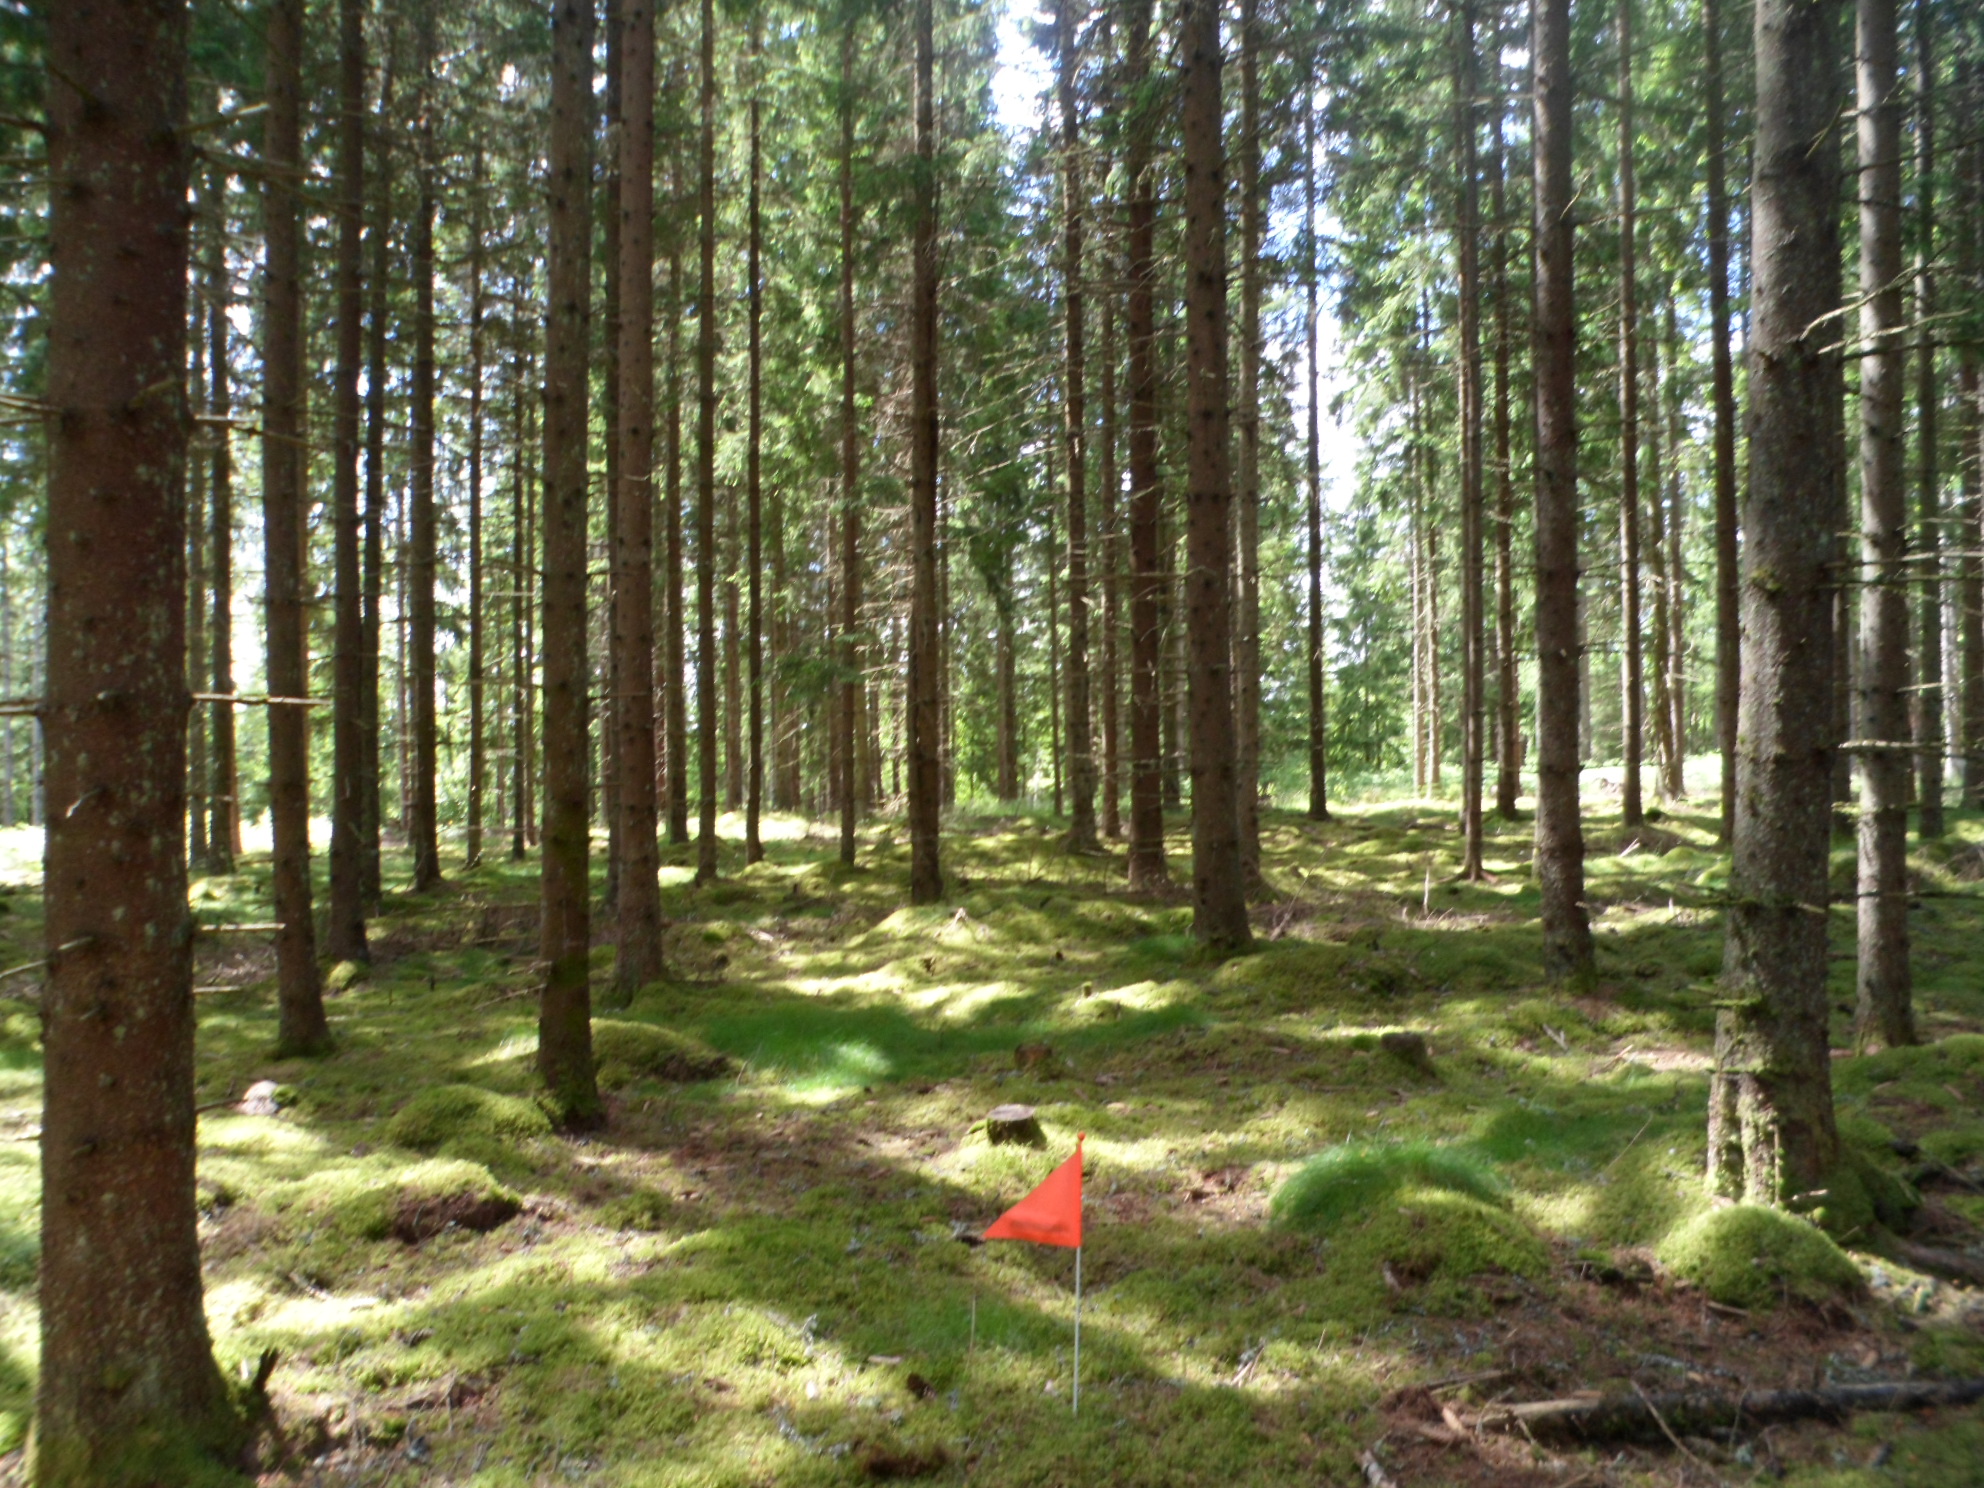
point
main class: Woodland
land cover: Spruce dominated coniferous woodland
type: boreal forest
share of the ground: 50 - 75 %
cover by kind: coniferous forest trees 65 %, lichens and mosses 20 %, shrubs 10 %, unconsolidated bare surface 5 %
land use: Forestry
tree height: > 5 m
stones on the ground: < 10 %
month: June
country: SE
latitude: 57.1080
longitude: 14.7682
